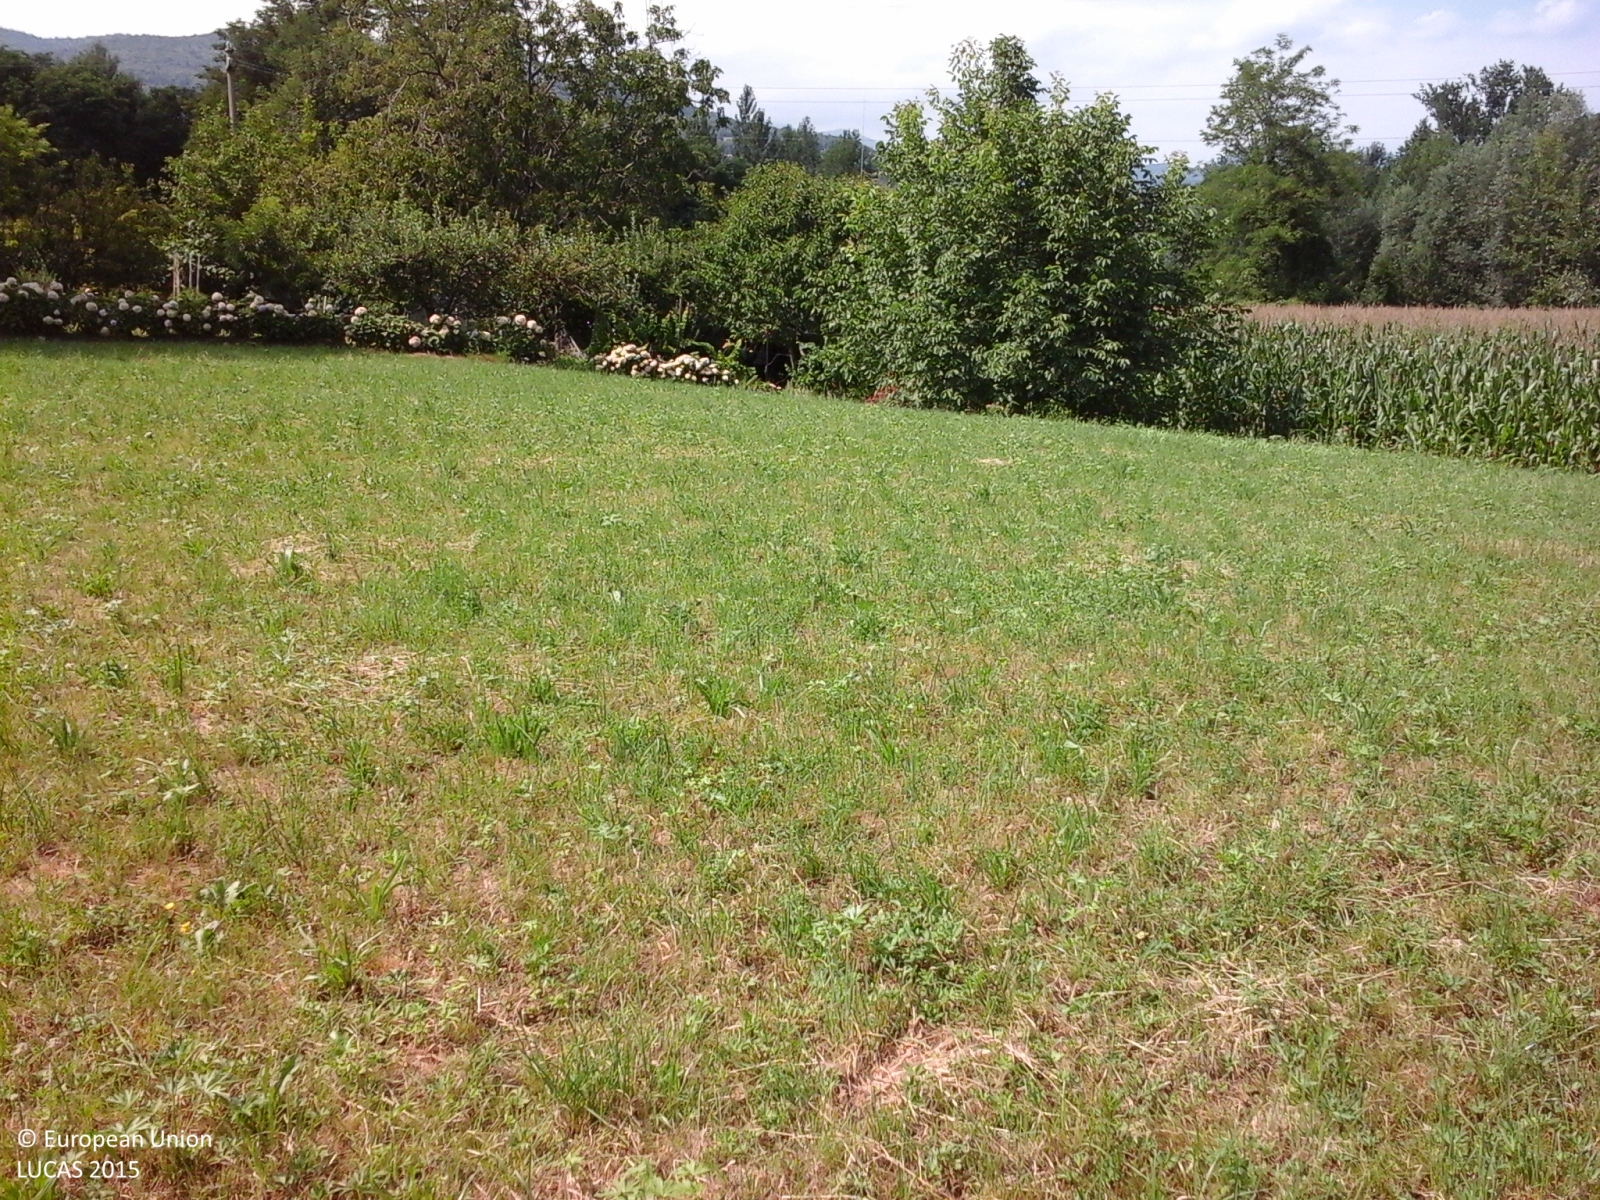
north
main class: Grassland
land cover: Grassland without tree/shrub cover
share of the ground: > 75 %
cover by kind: herbaceous plants 100 %
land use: Agriculture (excluding fallow land and kitchen gardens)
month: July
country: IT
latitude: 44.8750
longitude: 7.3086
